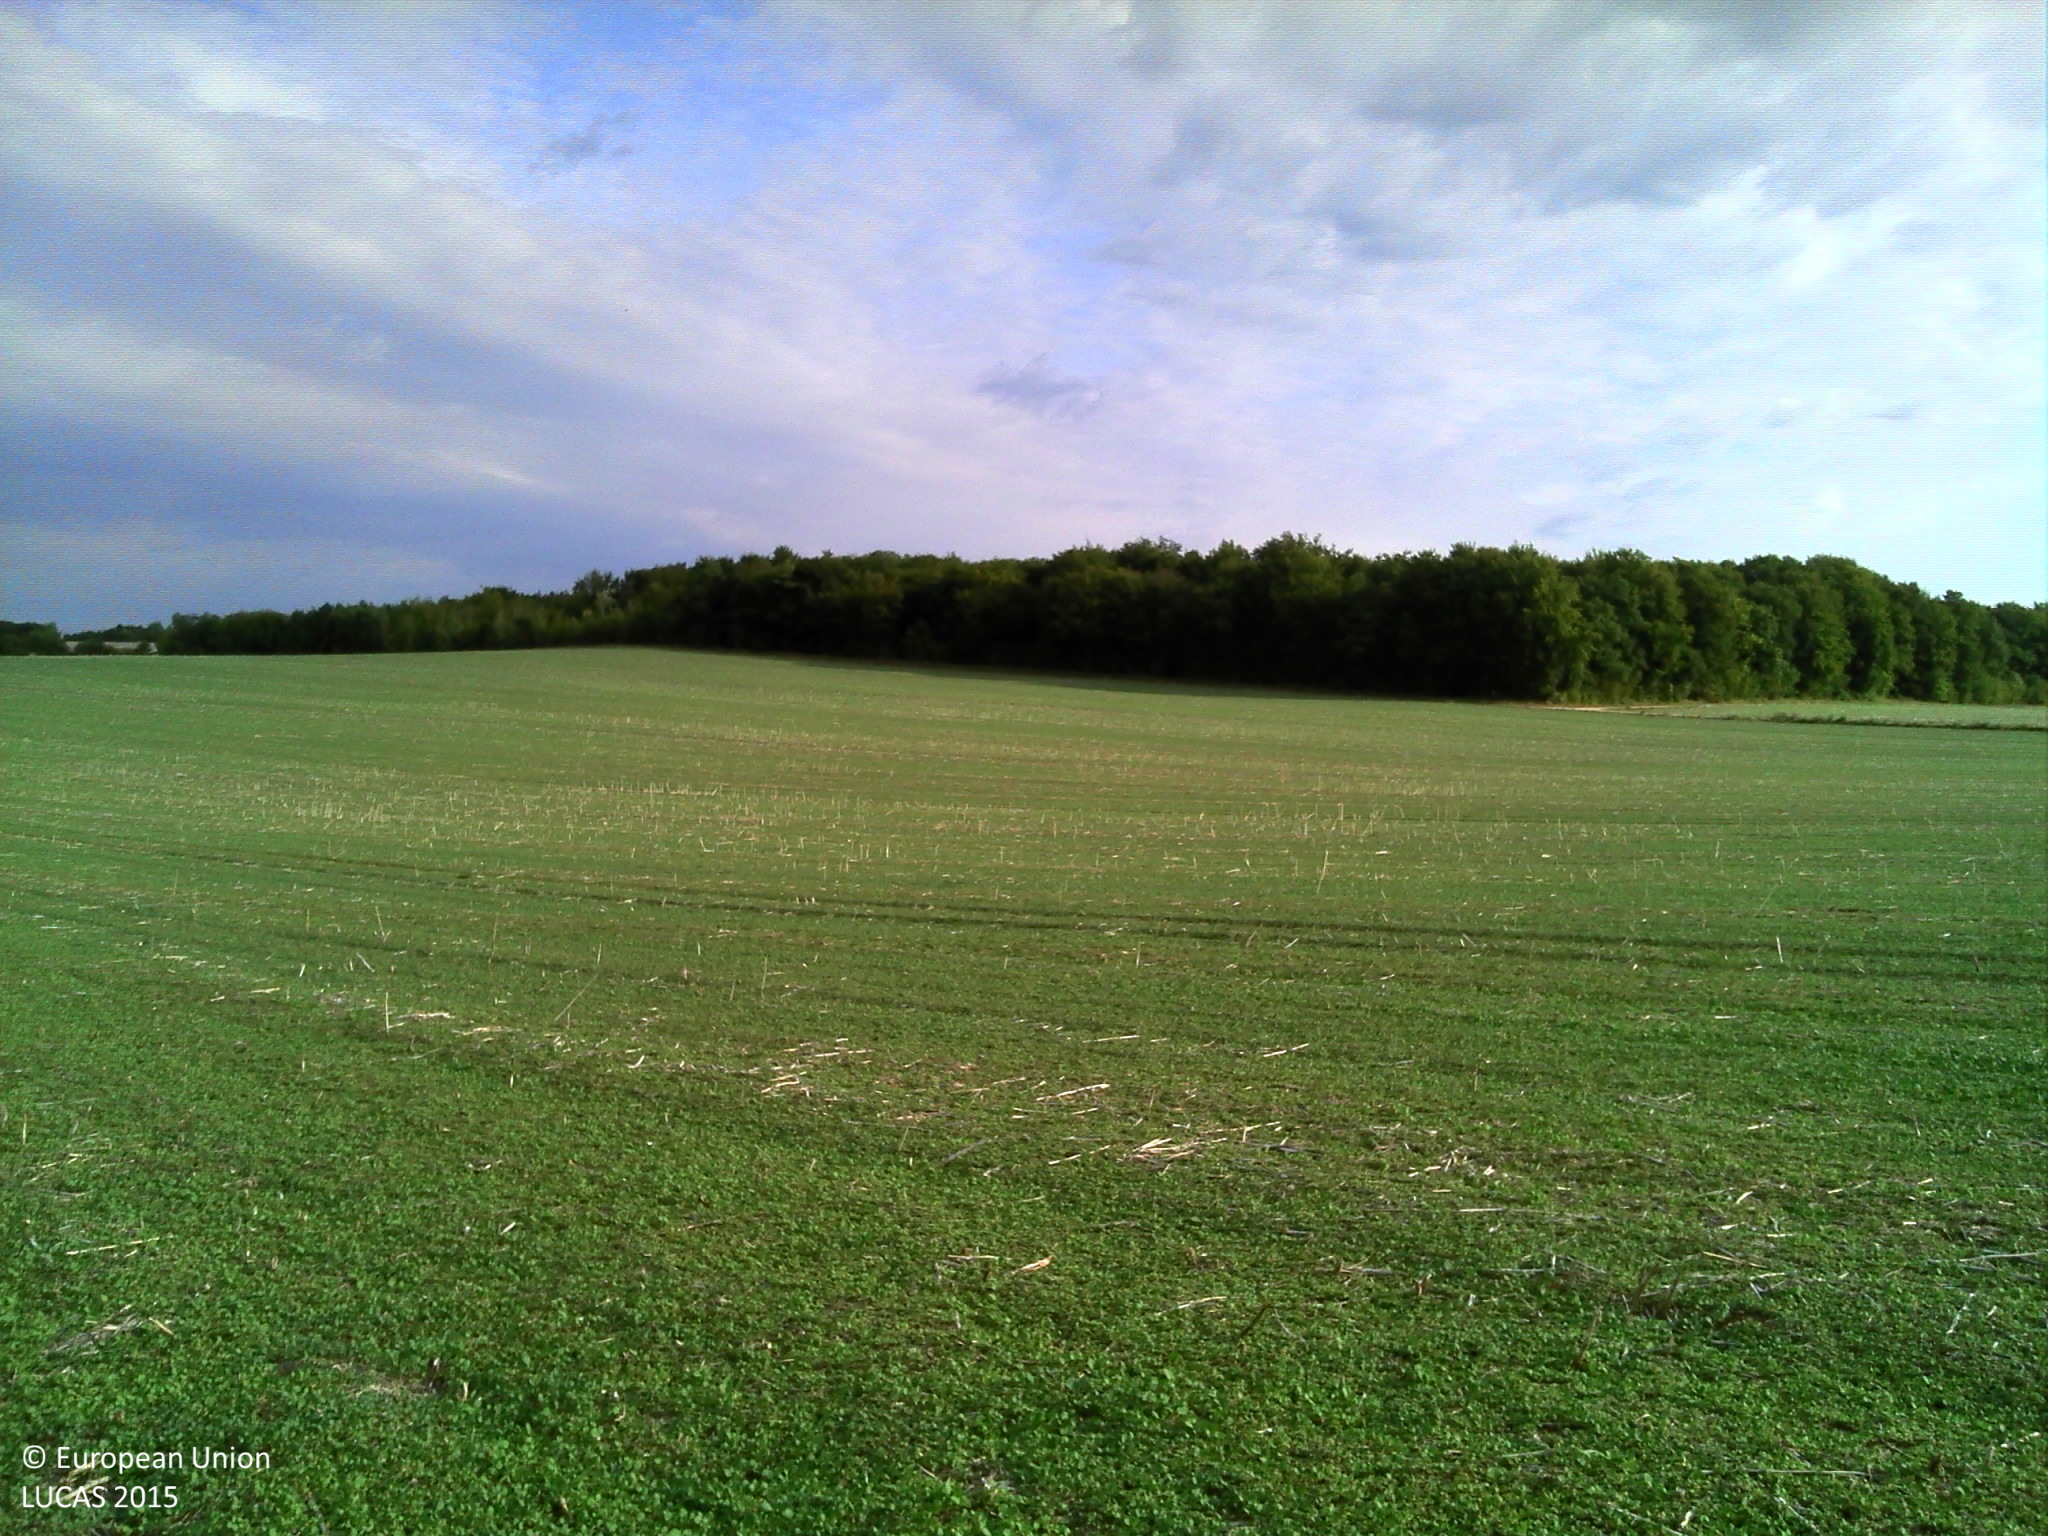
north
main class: Cropland
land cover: Rape and turnip rape
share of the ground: 25 - 50 %
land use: Agriculture (excluding fallow land and kitchen gardens)
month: August
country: FR
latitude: 47.6485
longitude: 4.7675
